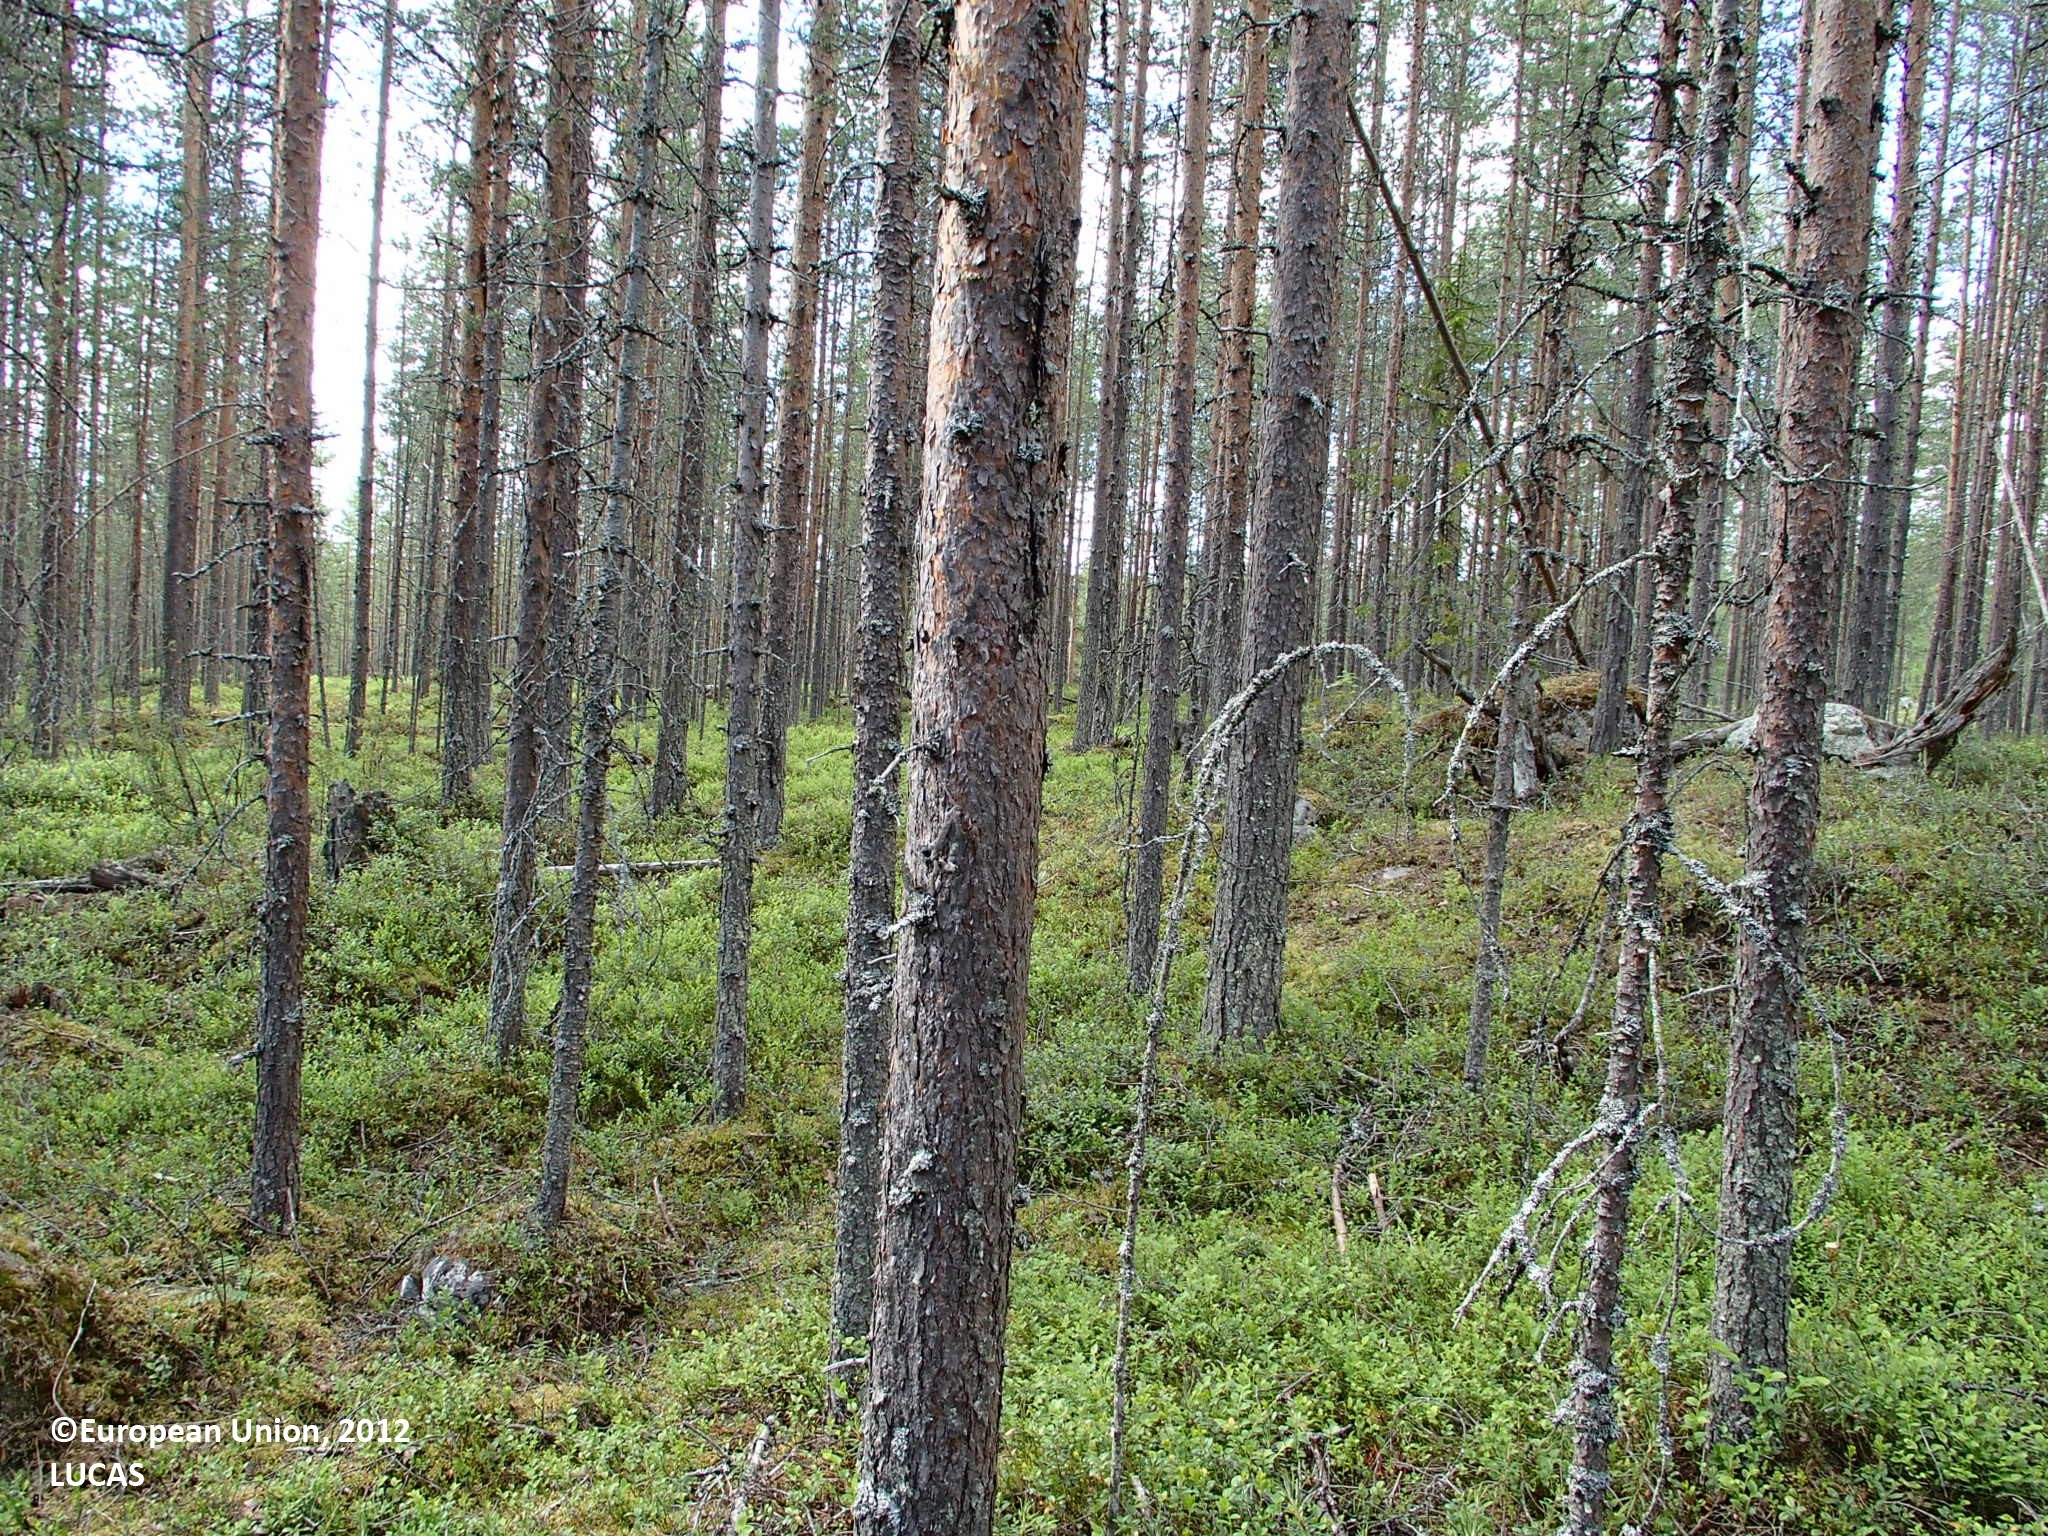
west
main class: Woodland
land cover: Pine dominated coniferous woodland
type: boreal forest
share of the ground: > 75 %
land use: Forestry
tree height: > 5 m
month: June
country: FI
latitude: 66.5785
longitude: 27.1701
